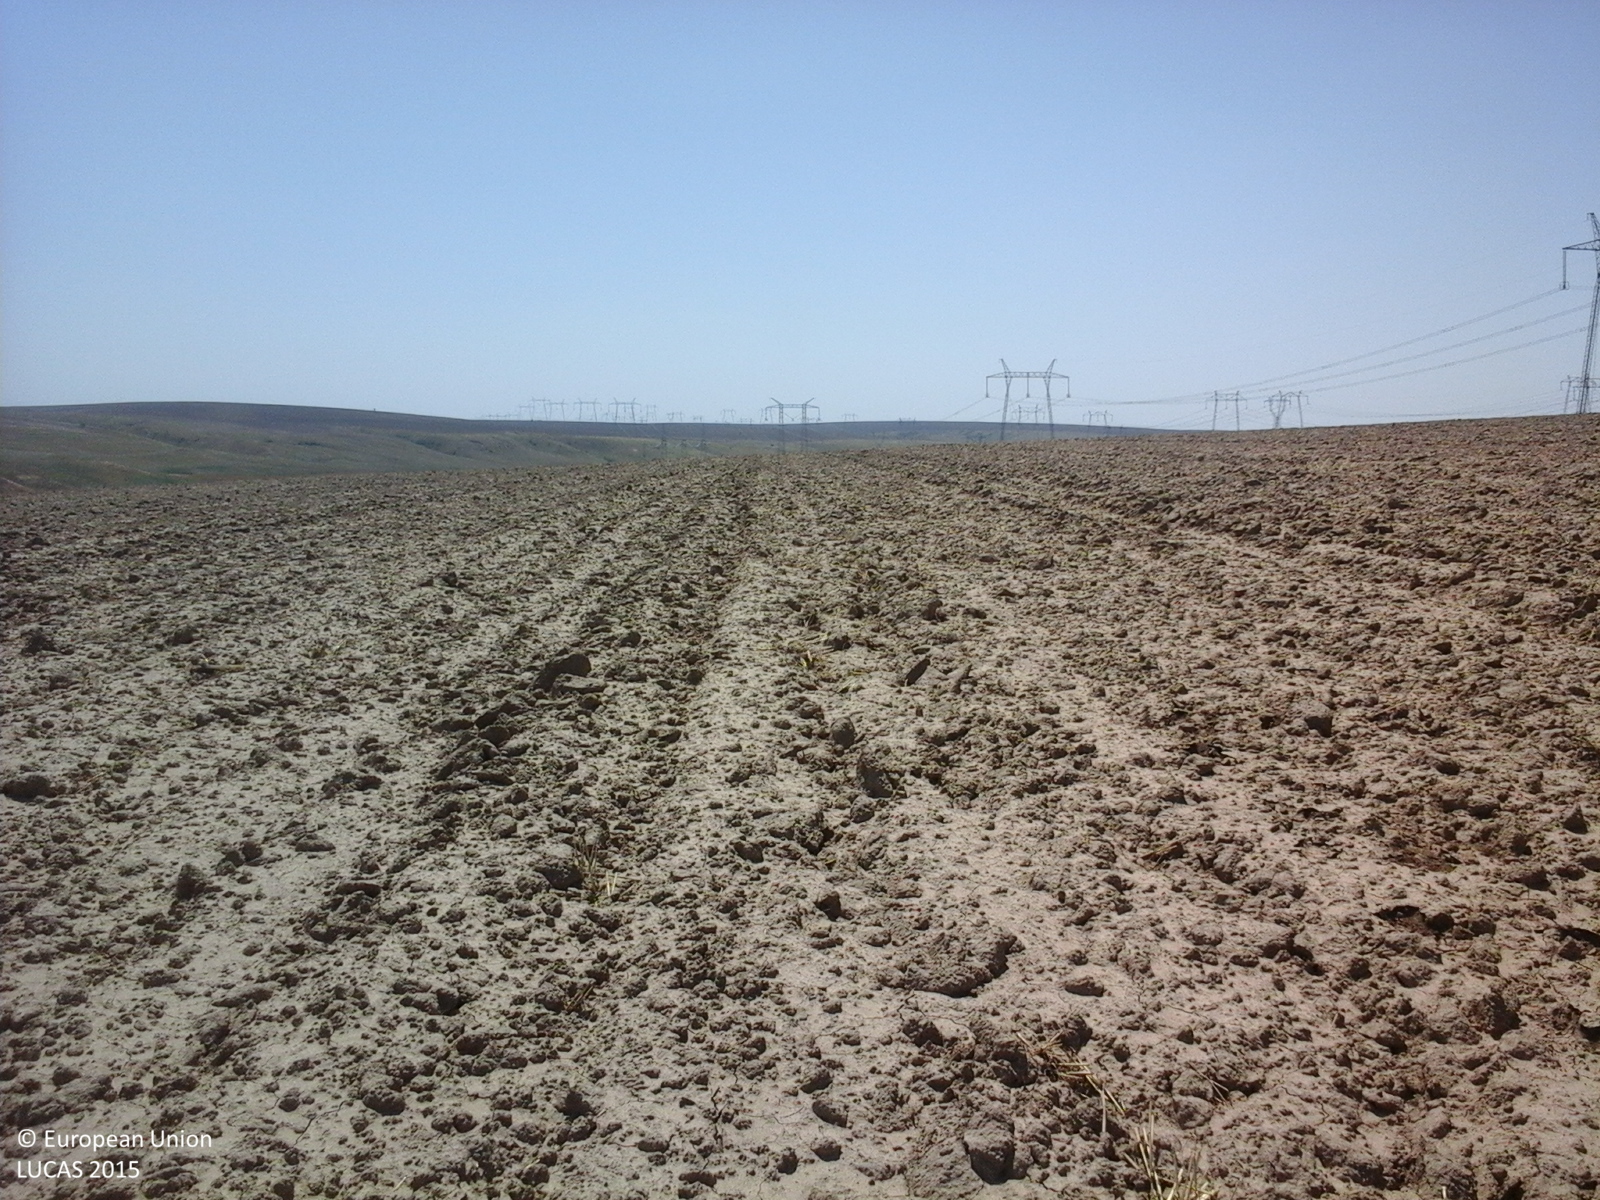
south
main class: Cropland
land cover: Common wheat
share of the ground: < 10 %
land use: Agriculture (excluding fallow land and kitchen gardens)
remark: Harvested field
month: August
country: RO
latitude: 44.4634
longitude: 28.1744
